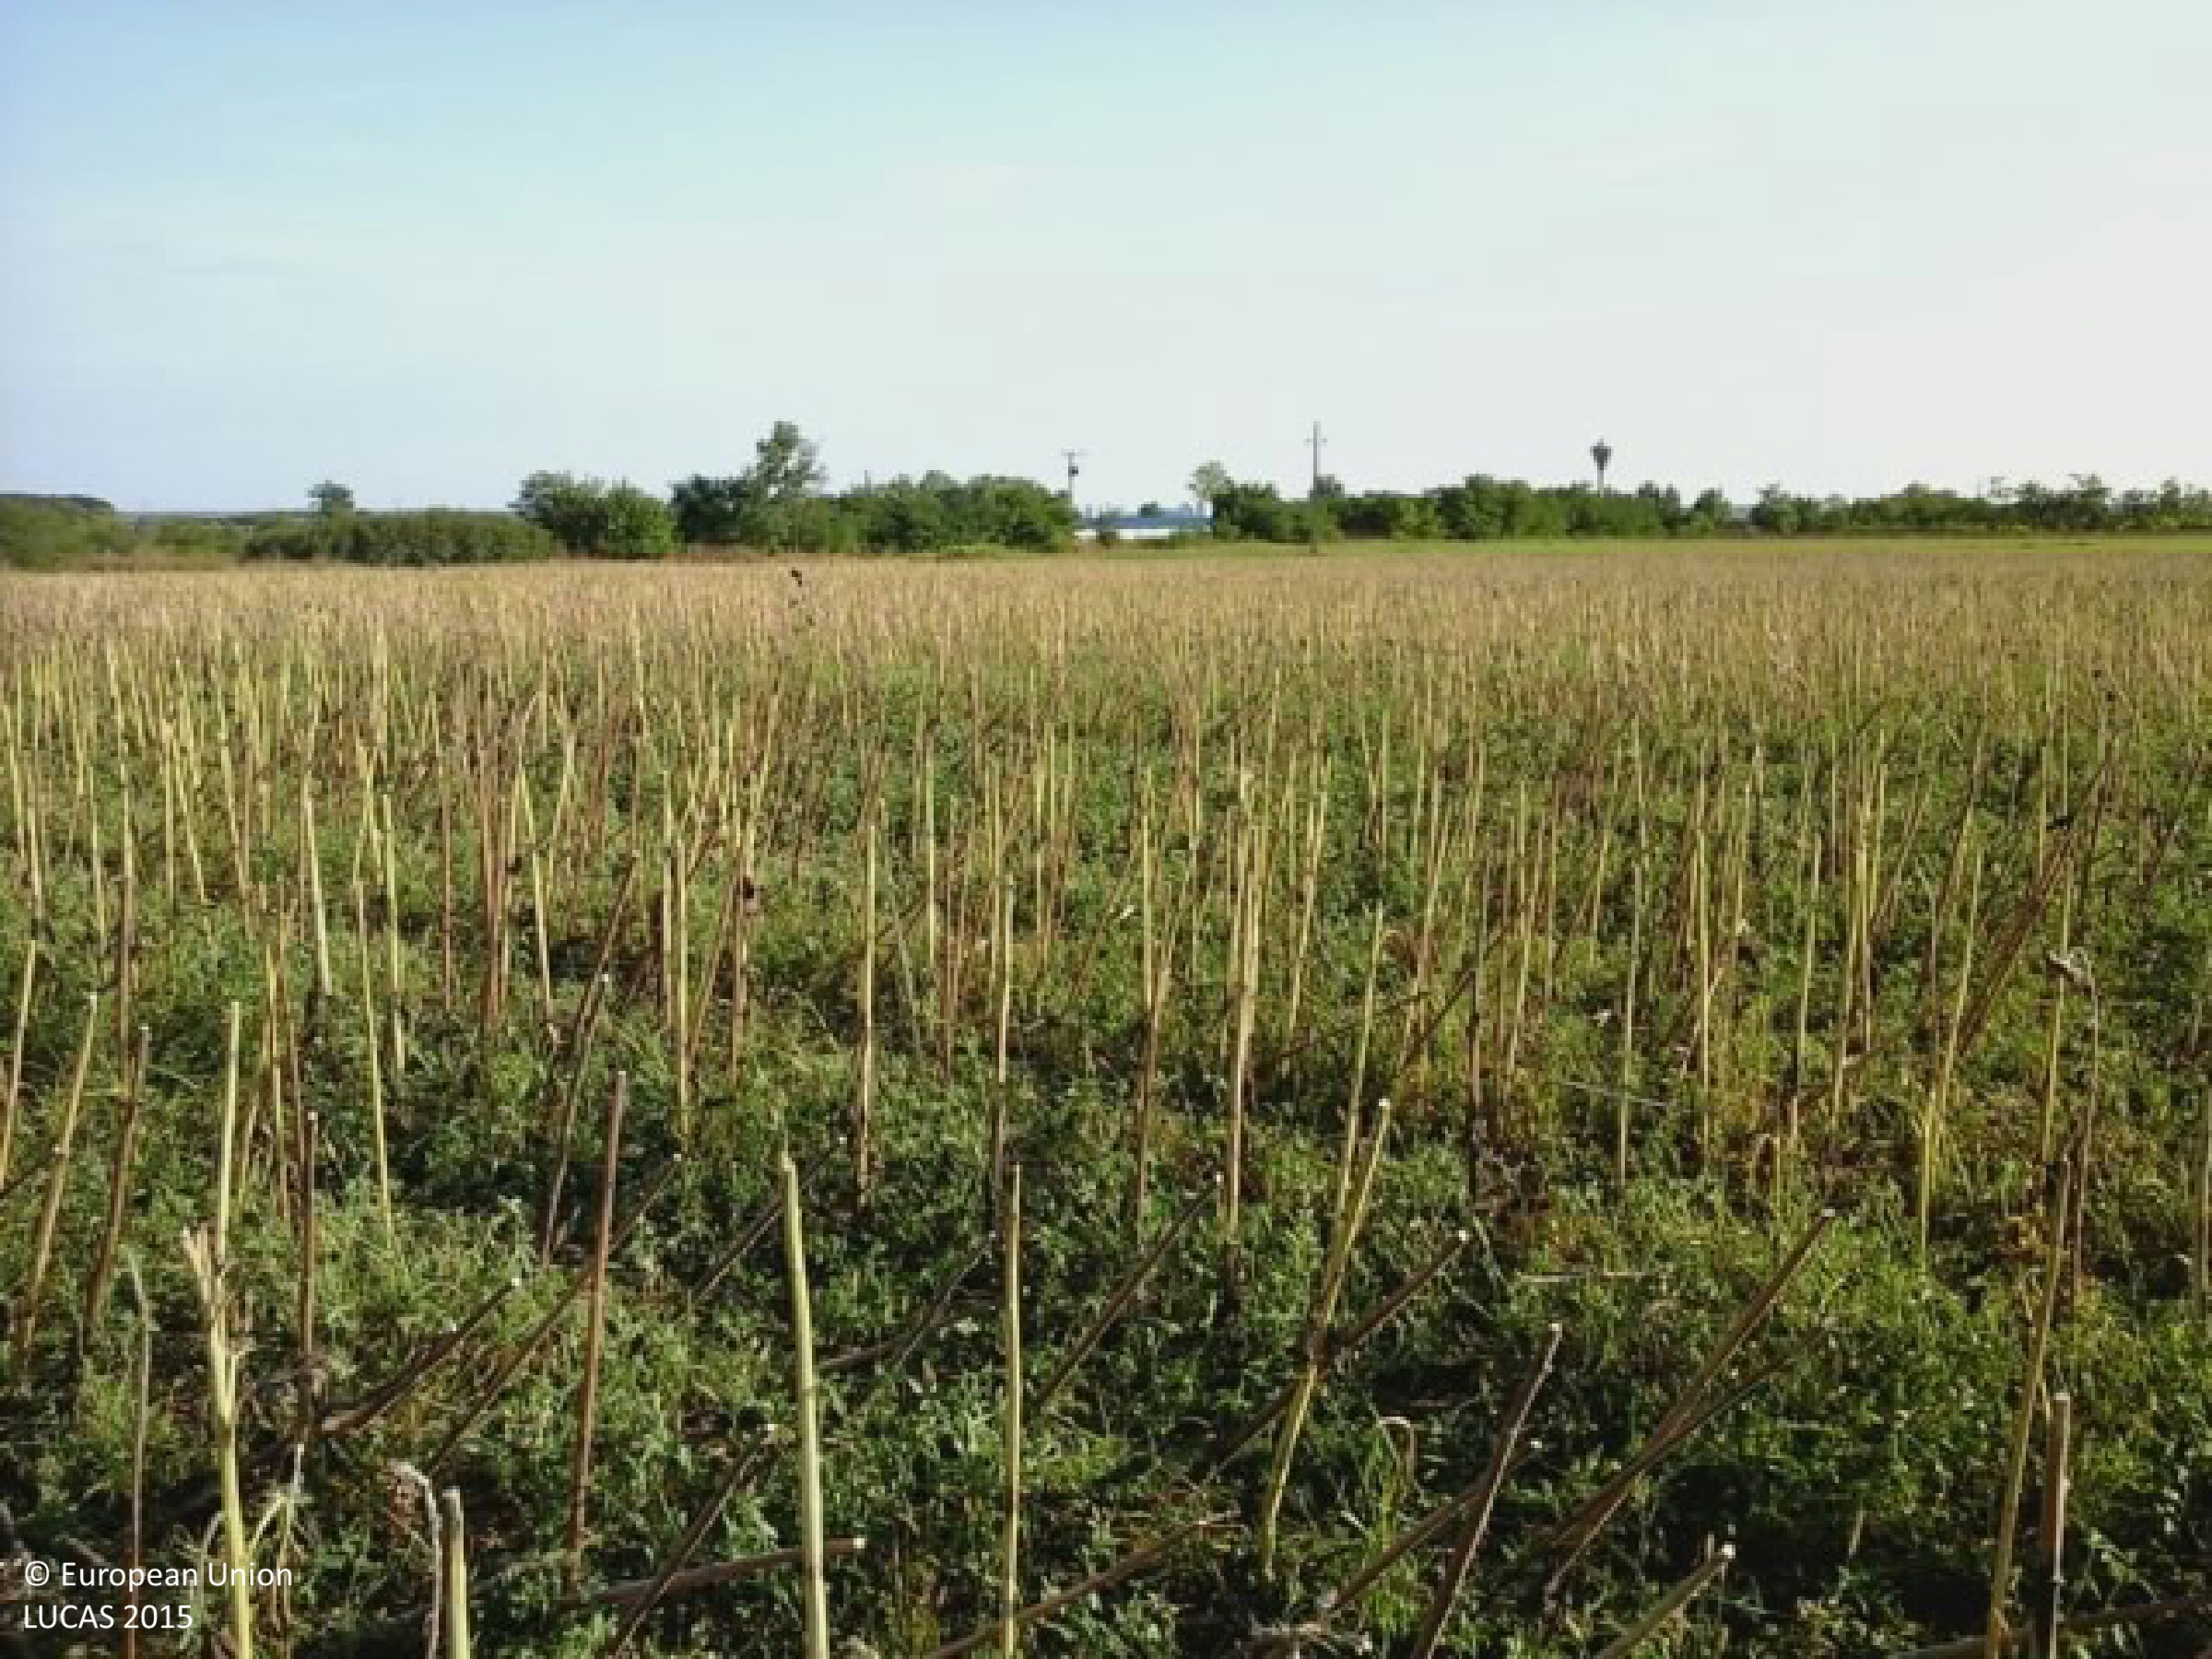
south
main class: Cropland
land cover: Sunflower
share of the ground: < 10 %
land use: Agriculture (excluding fallow land and kitchen gardens)
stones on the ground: < 10 %
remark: Harvested field
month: September
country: HU
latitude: 47.6889
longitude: 19.8712
